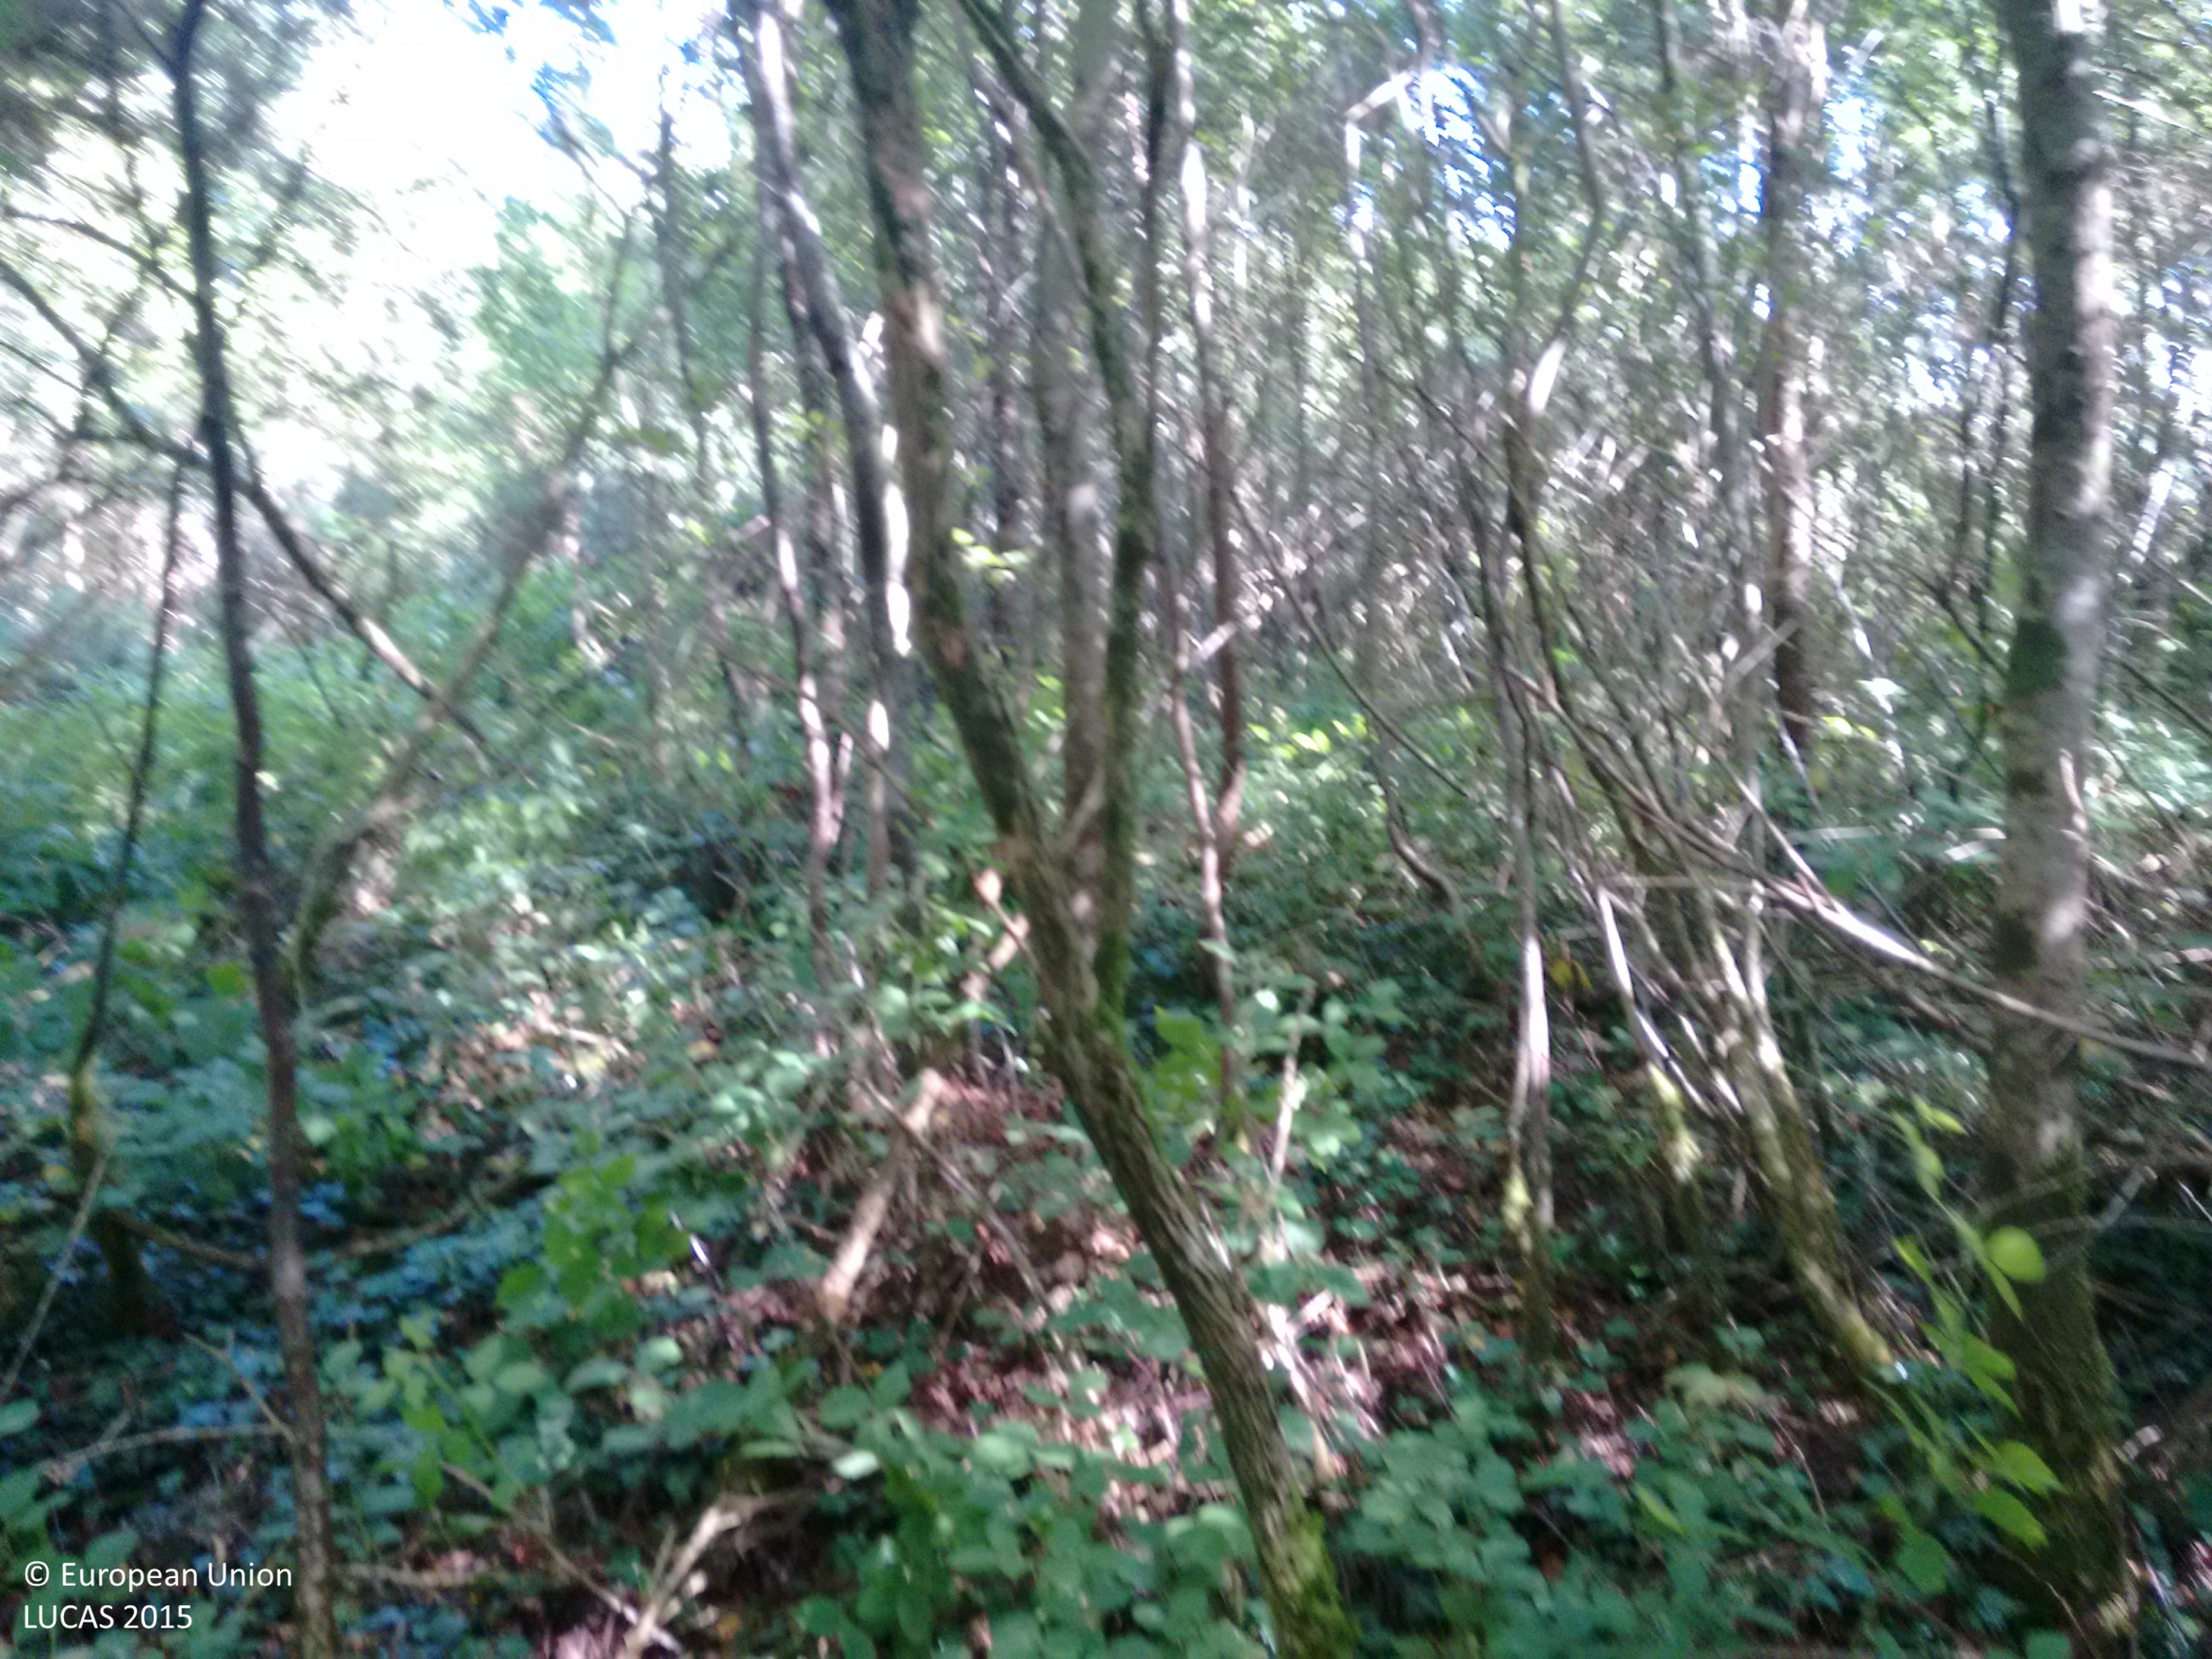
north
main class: Woodland
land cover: Broadleaved woodland
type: acidophilous oak and oak-birch forest
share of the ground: > 75 %
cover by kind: broadleaved forest trees 100 %
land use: Semi-natural and natural areas not in use
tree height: > 5 m
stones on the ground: < 10 %
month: August
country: IE
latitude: 51.8957
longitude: -9.5479
